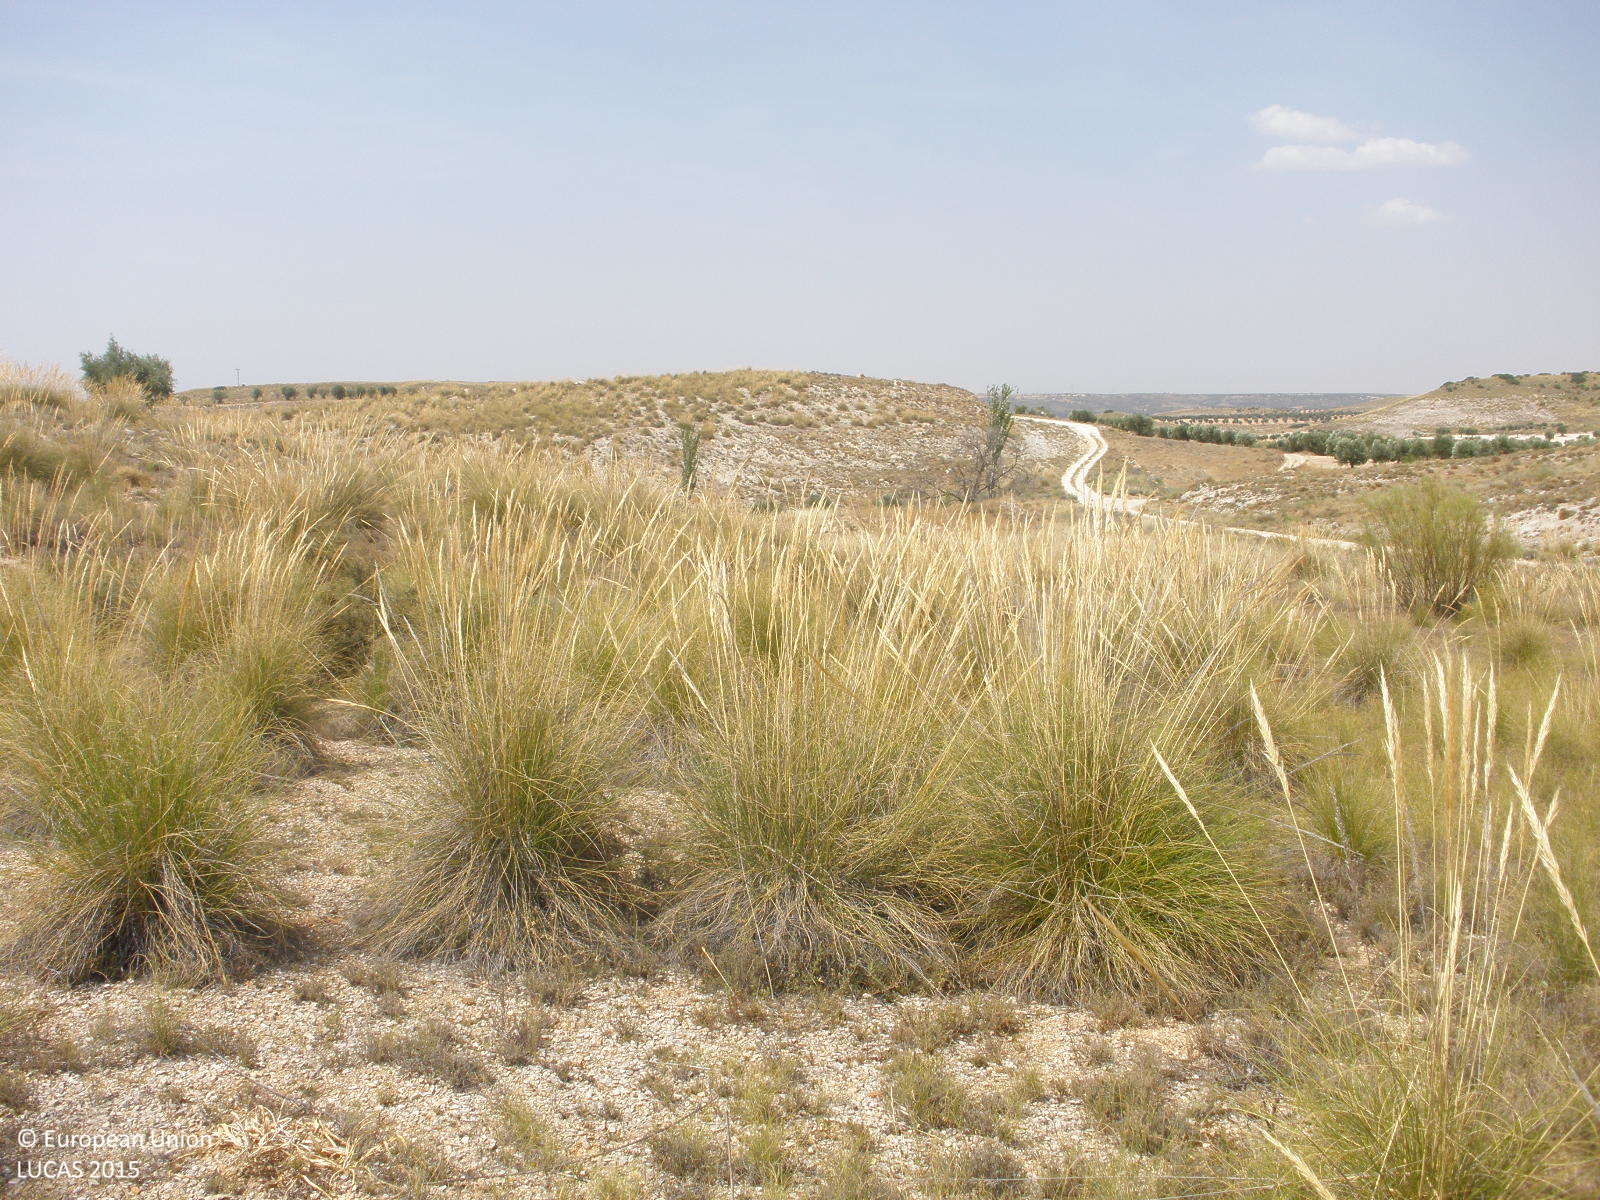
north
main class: Shrubland
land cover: Shrubland without tree cover
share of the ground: 10 - 25 %
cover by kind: herbaceous plants 70 %, shrubs 15 %, consolidated bare surface 15 %
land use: Semi-natural and natural areas not in use
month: July
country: ES
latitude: 40.1815
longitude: -3.4314
